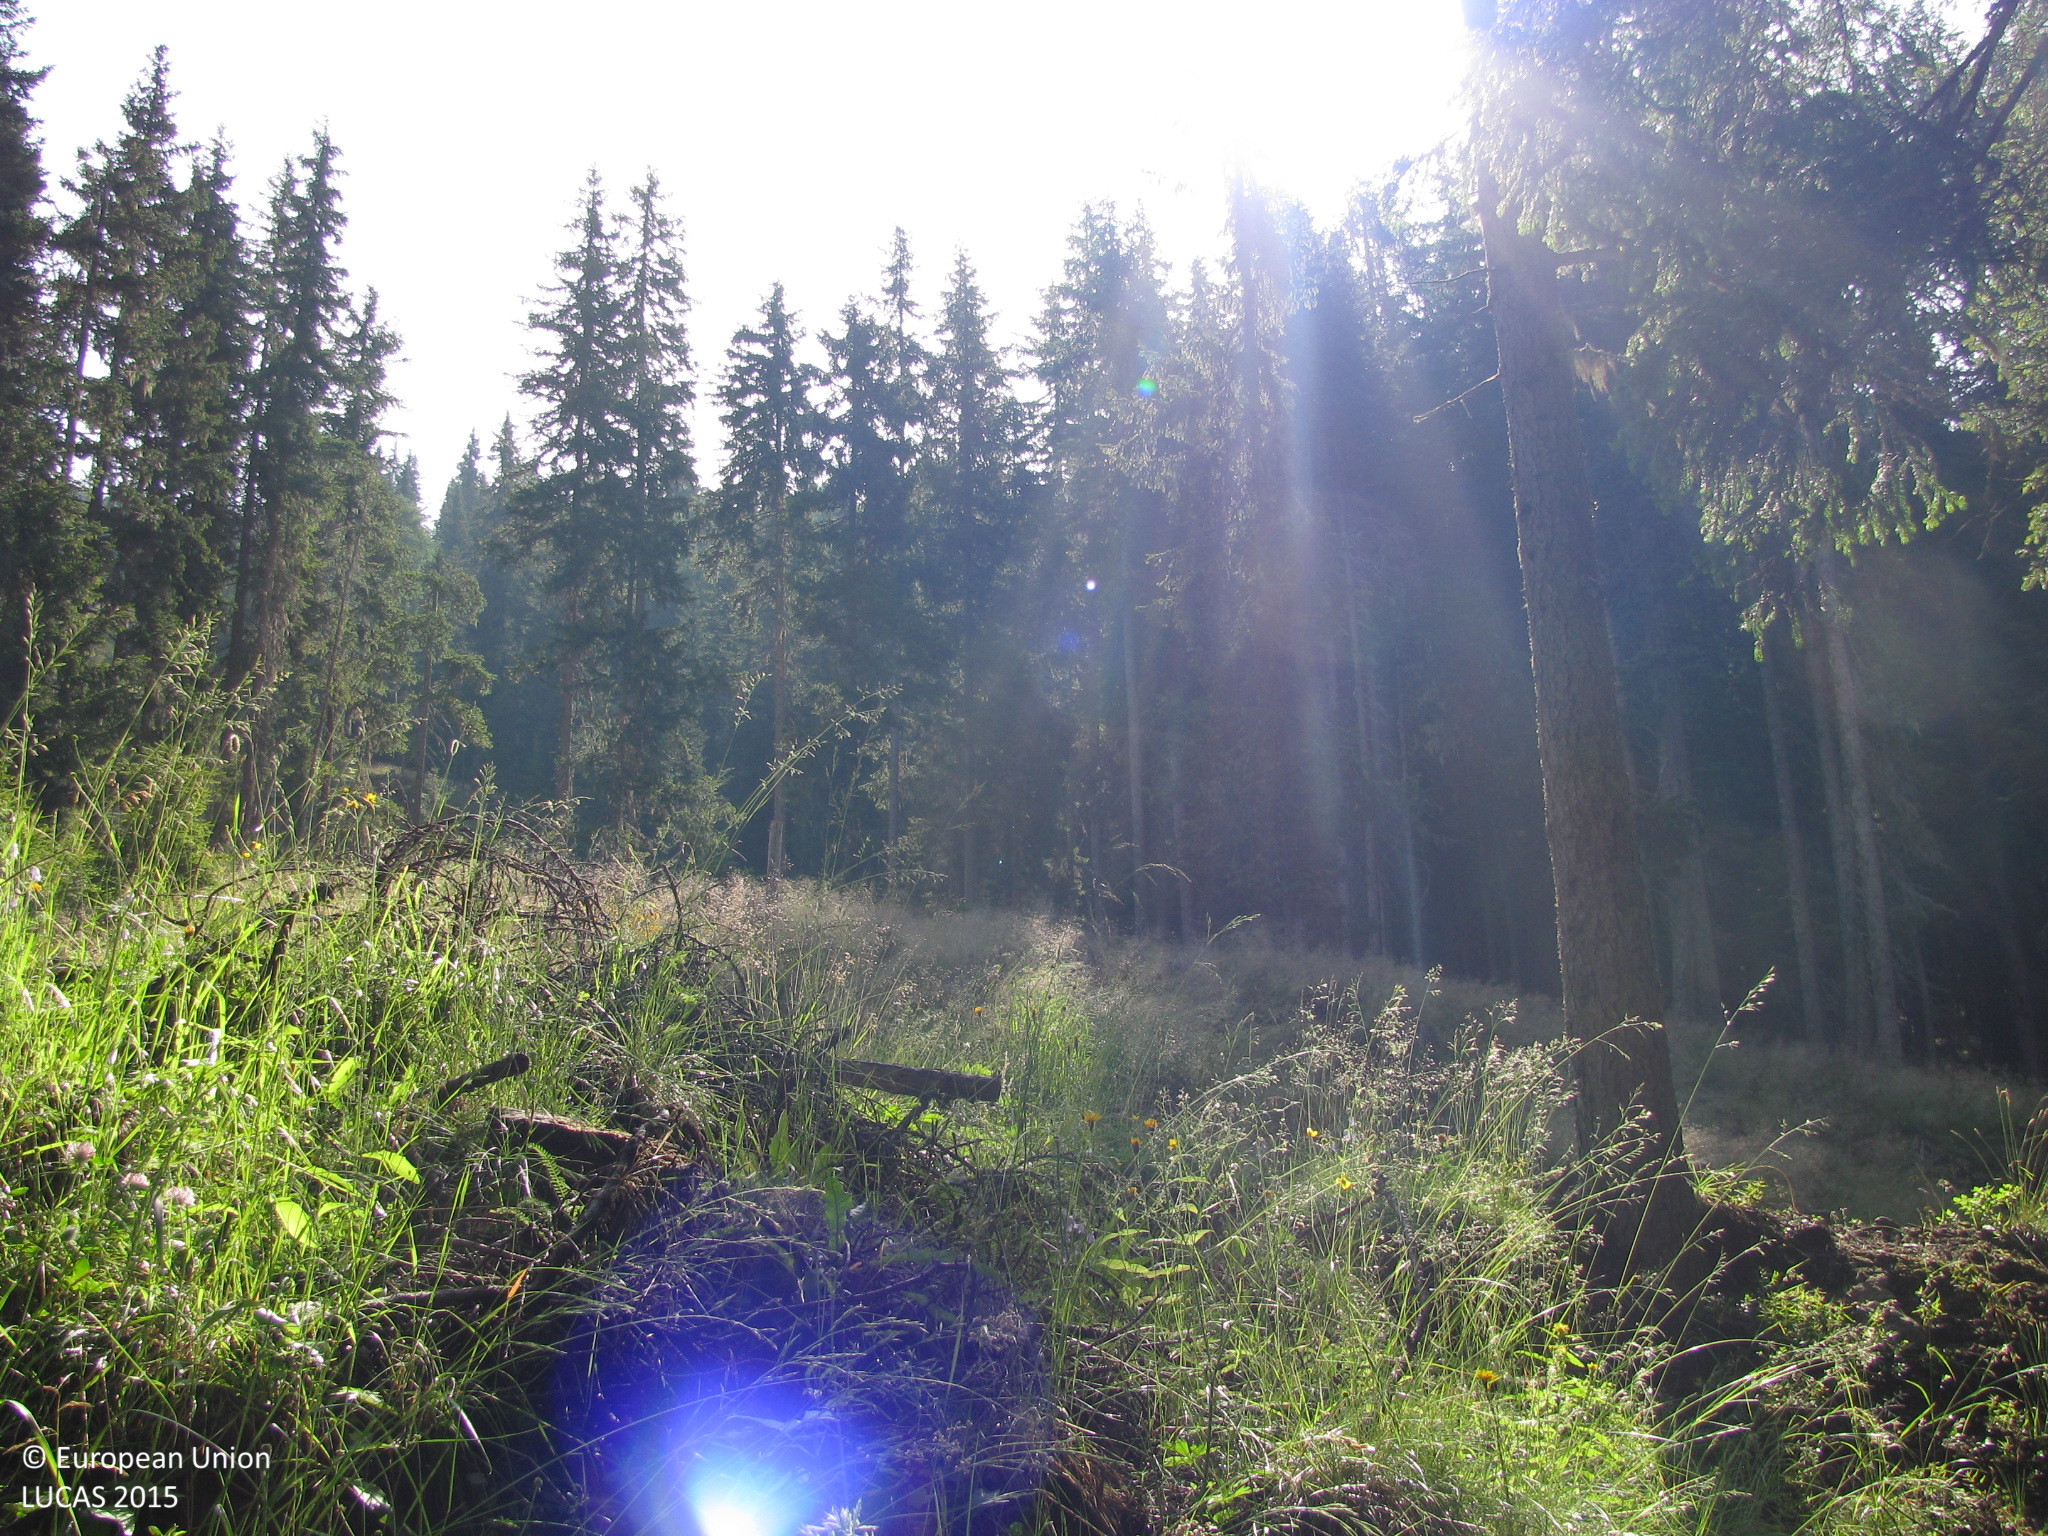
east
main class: Woodland
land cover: Spruce dominated coniferous woodland
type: alpine coniferous forest
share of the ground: > 75 %
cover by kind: coniferous forest trees 80 %, herbaceous plants 10 %, shrubs 5 %, lichens and mosses 5 %
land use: Forestry
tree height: > 5 m
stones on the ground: 25 - 50 %
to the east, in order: Spruce dominated coniferous woodland; Tracks; Grassland with sparse tree/shrub cover; Spruce dominated coniferous woodland
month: July
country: AT
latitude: 46.8300
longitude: 12.3444
